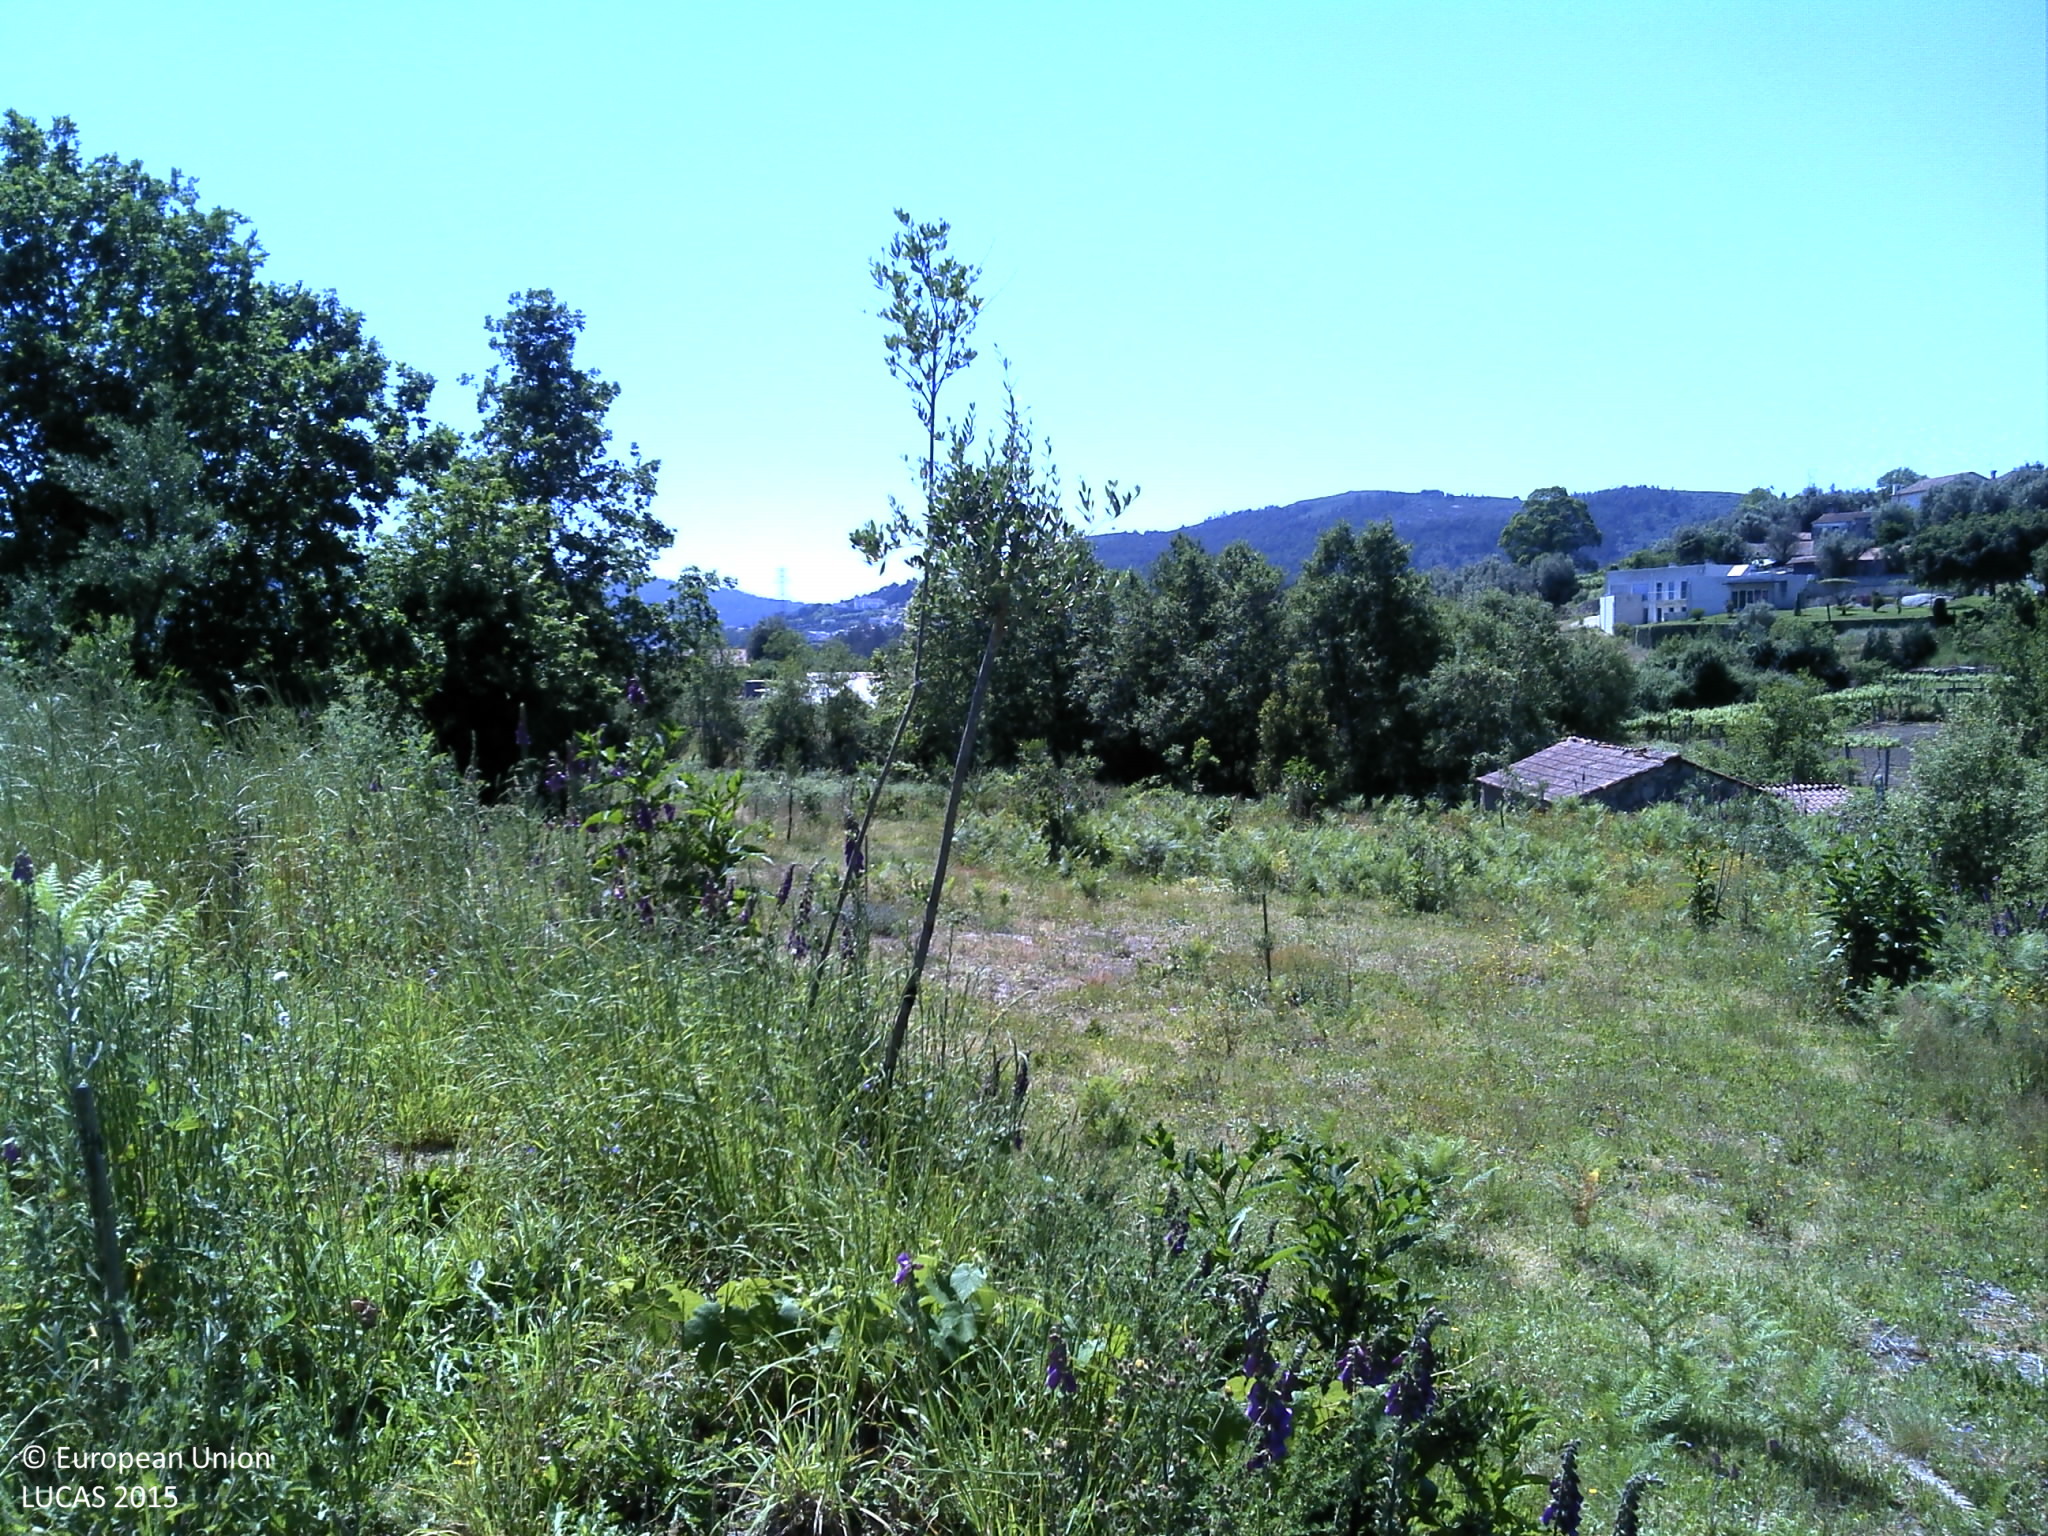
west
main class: Cropland
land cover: Olive groves
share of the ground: < 10 %
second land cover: Grassland without tree/shrub cover
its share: 50 - 75 %
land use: Agriculture (excluding fallow land and kitchen gardens)
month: May
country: PT
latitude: 41.6494
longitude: -8.6162
